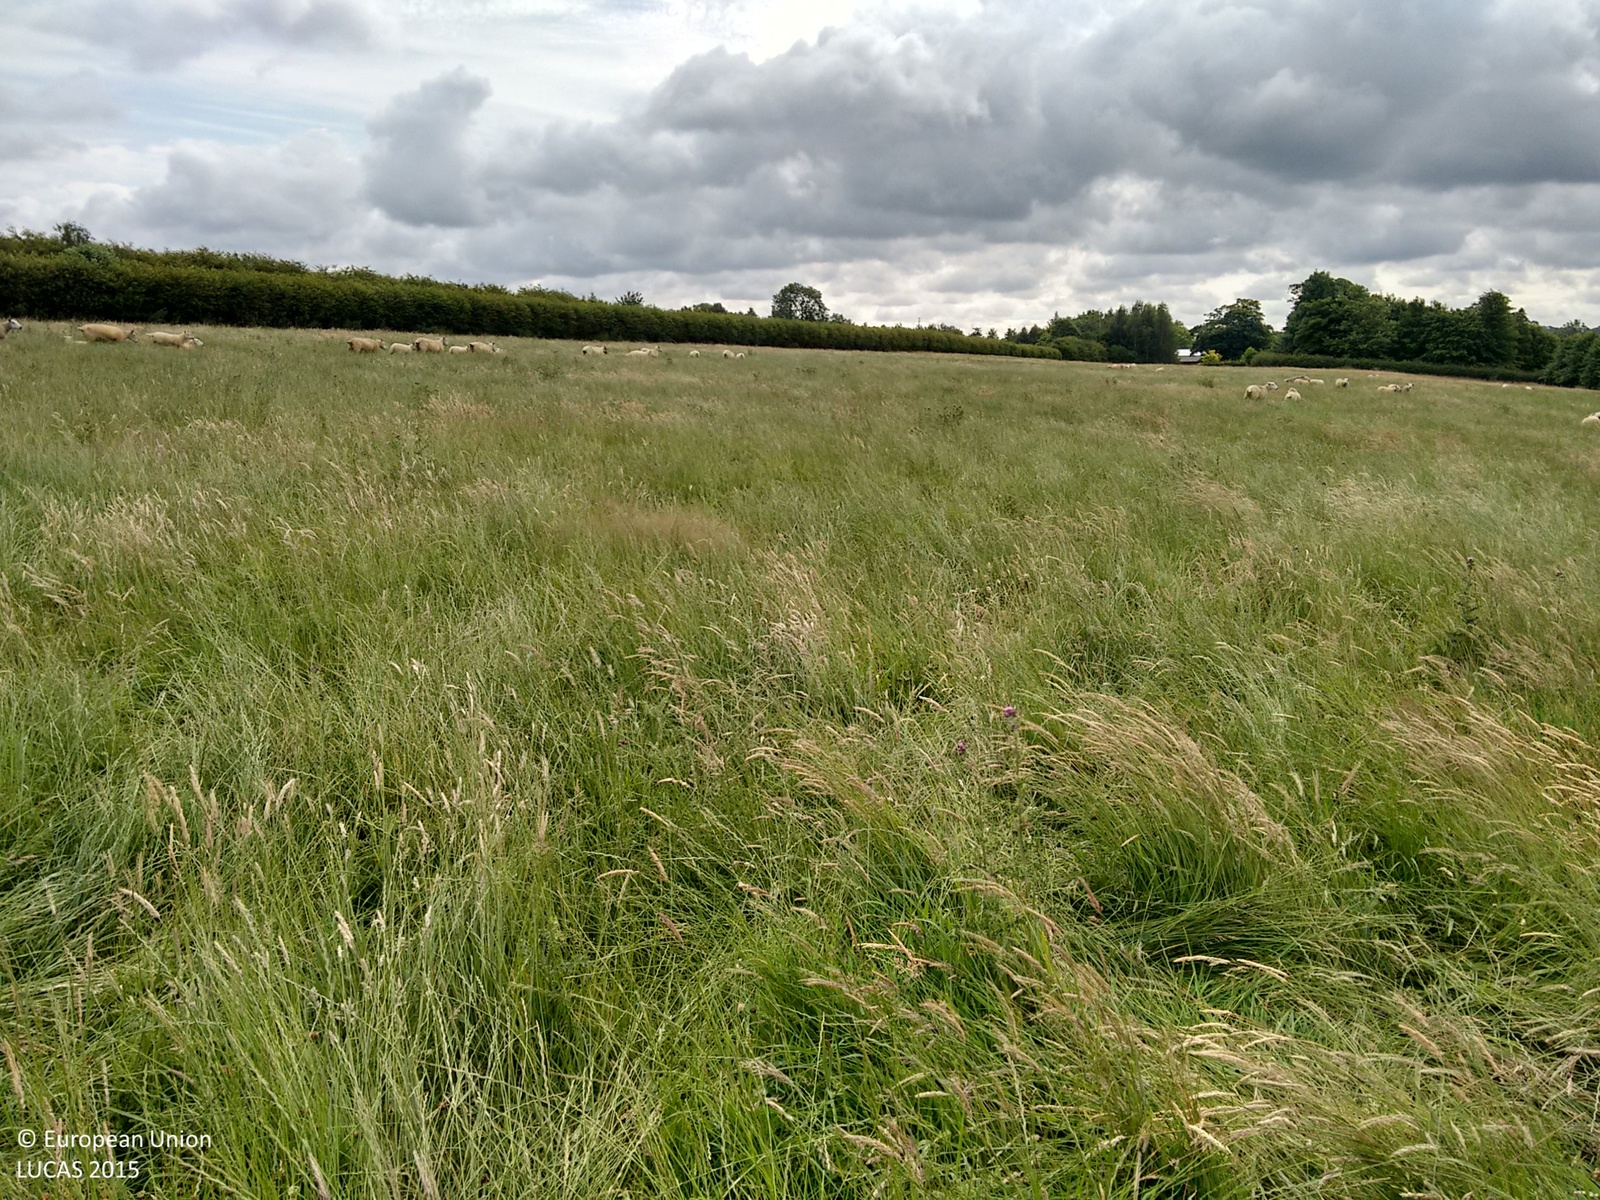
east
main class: Grassland
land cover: Grassland without tree/shrub cover
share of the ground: > 75 %
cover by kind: herbaceous plants 100 %
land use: Agriculture (excluding fallow land and kitchen gardens)
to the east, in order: Grassland without tree/shrub cover; Fences; Managed hedges; Grass margins; Tracks; Grass margins; Managed hedges; Grassland without tree/shrub cover
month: July
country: GB
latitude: 52.6287
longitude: -0.7821
